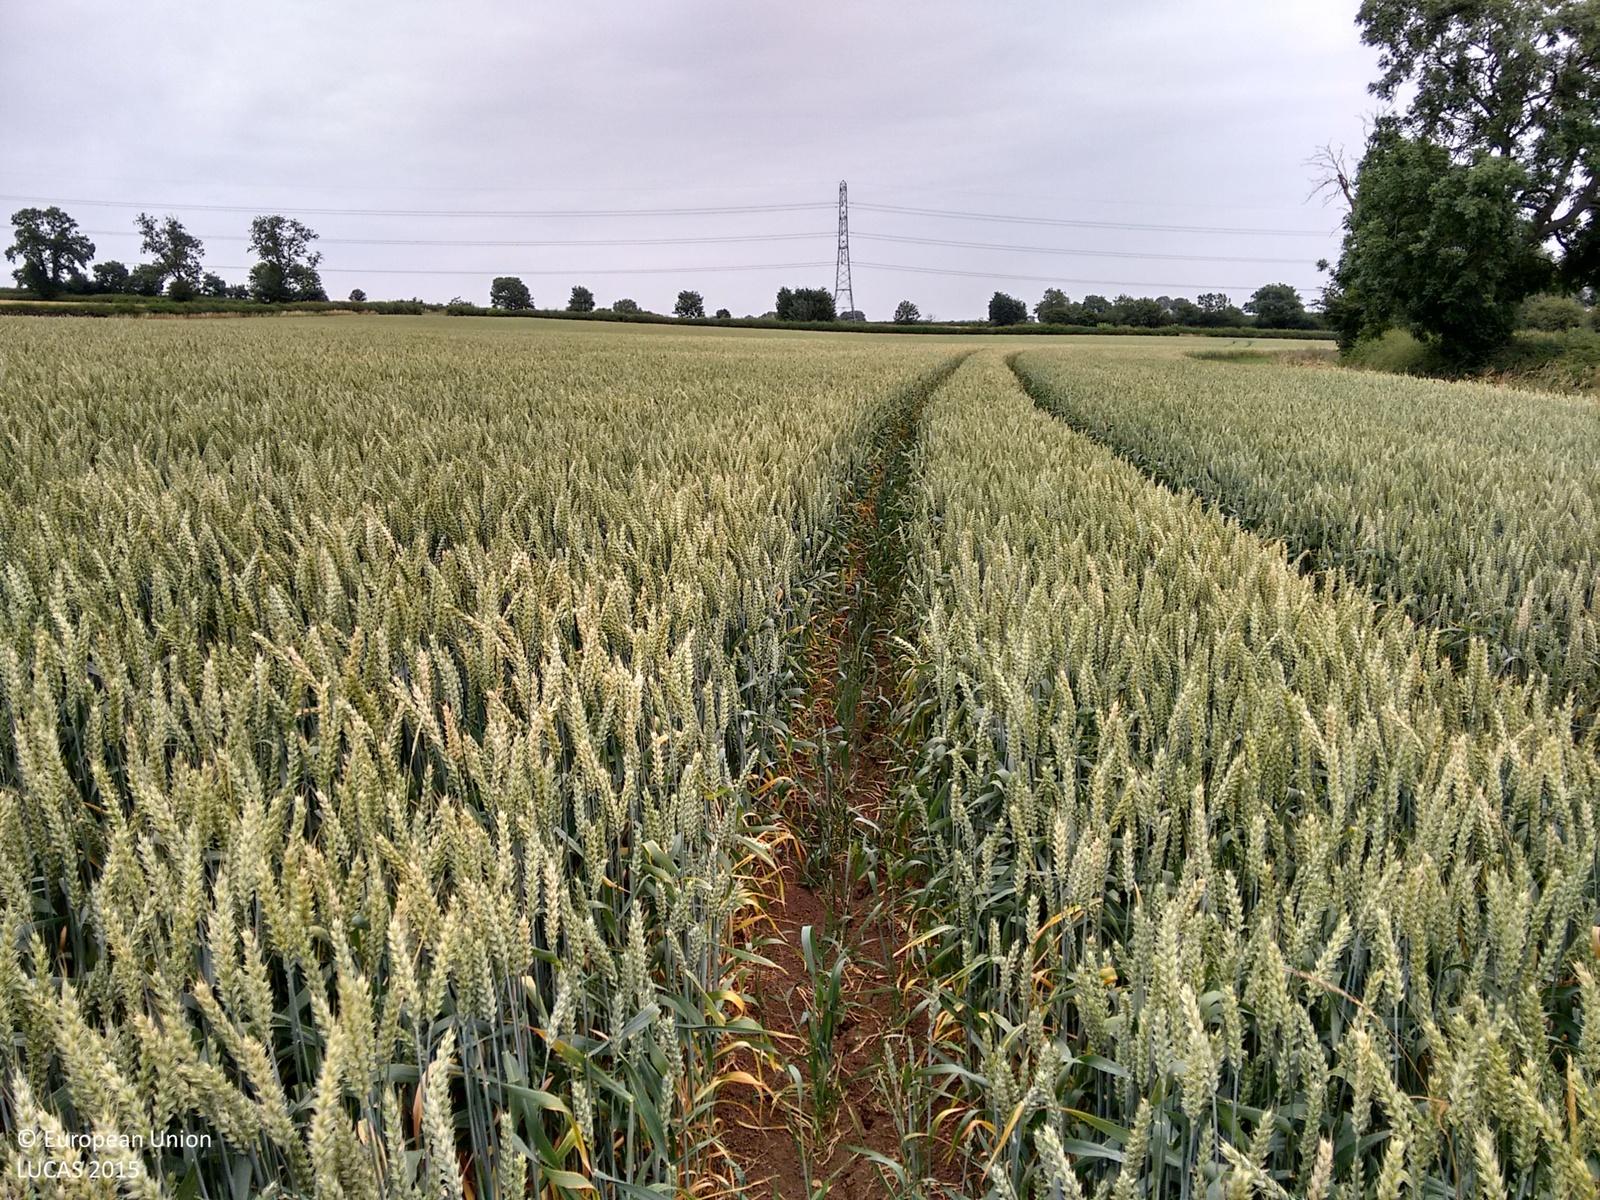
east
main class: Cropland
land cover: Common wheat
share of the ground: > 75 %
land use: Agriculture (excluding fallow land and kitchen gardens)
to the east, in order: Common wheat; Grass margins; Managed hedges; Grass margins; Paved roads, cycling and walking lanes; Grass margins; Ditches and canals; Managed hedges; Grassland without tree/shrub cover
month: July
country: GB
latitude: 52.7395
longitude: -0.9596
